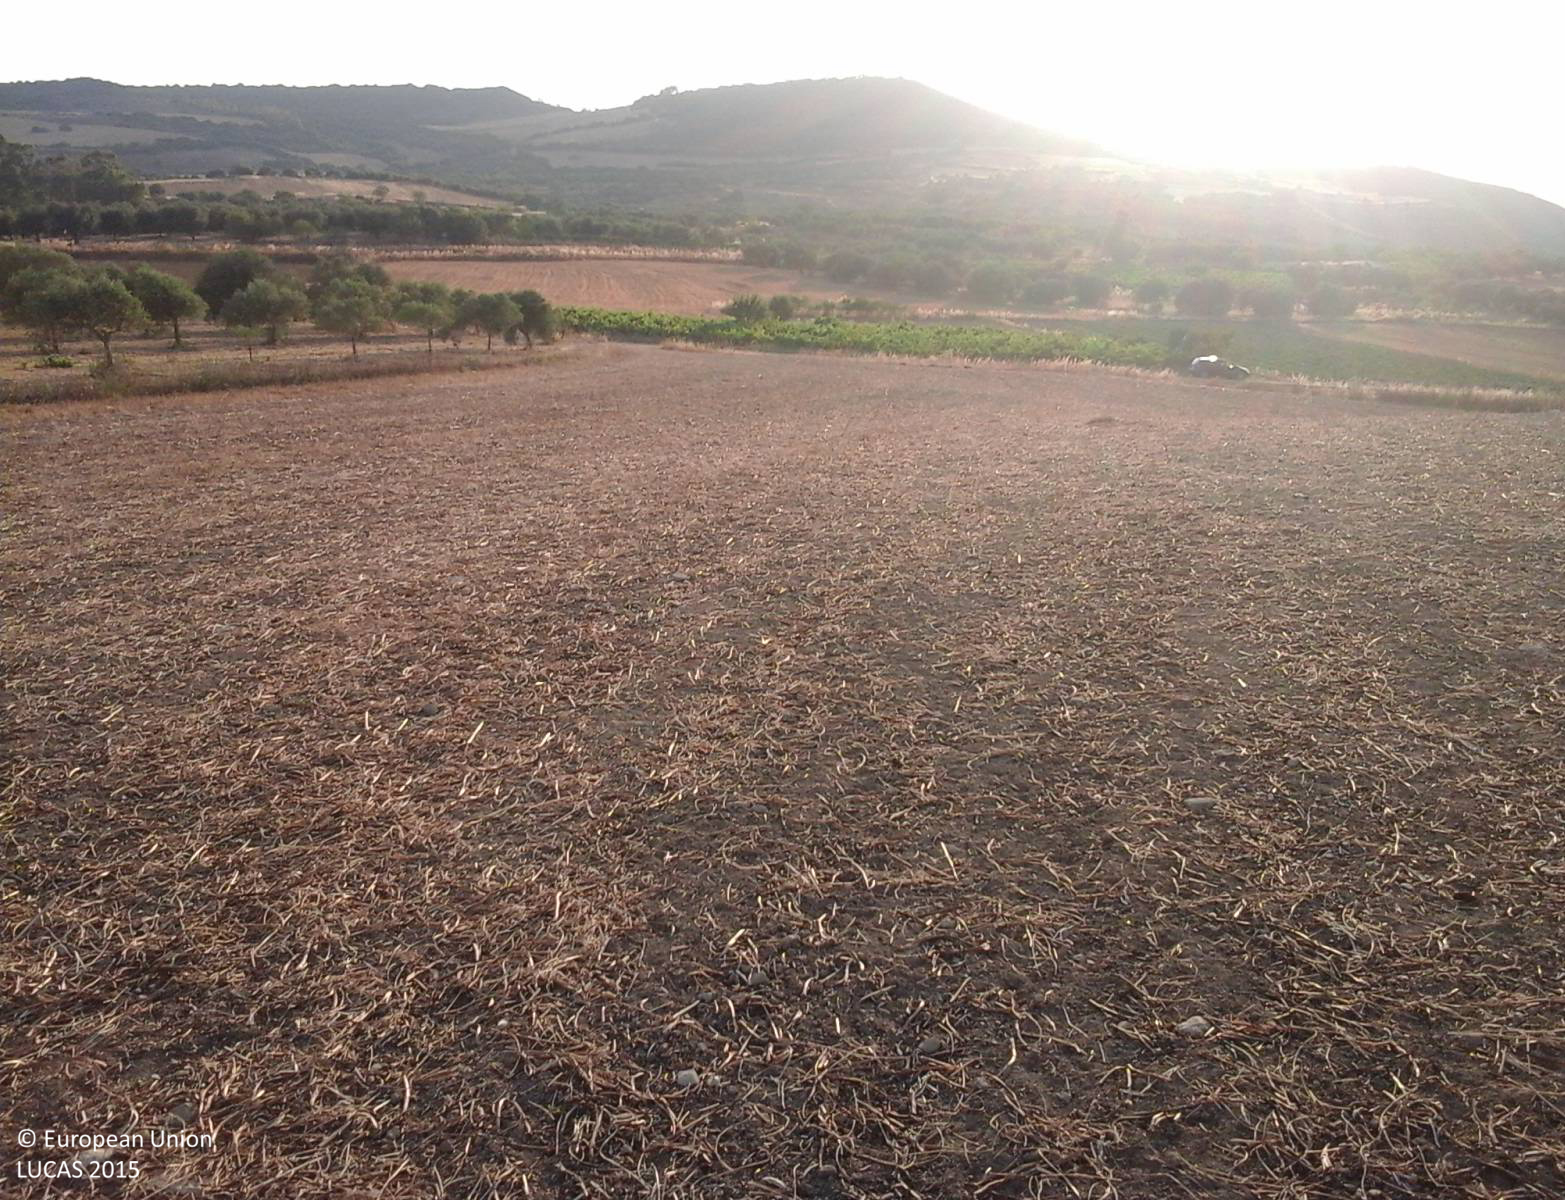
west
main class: Cropland
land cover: Dry pulses
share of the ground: > 75 %
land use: Agriculture (excluding fallow land and kitchen gardens)
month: July
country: IT
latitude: 39.6998
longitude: 8.8984
